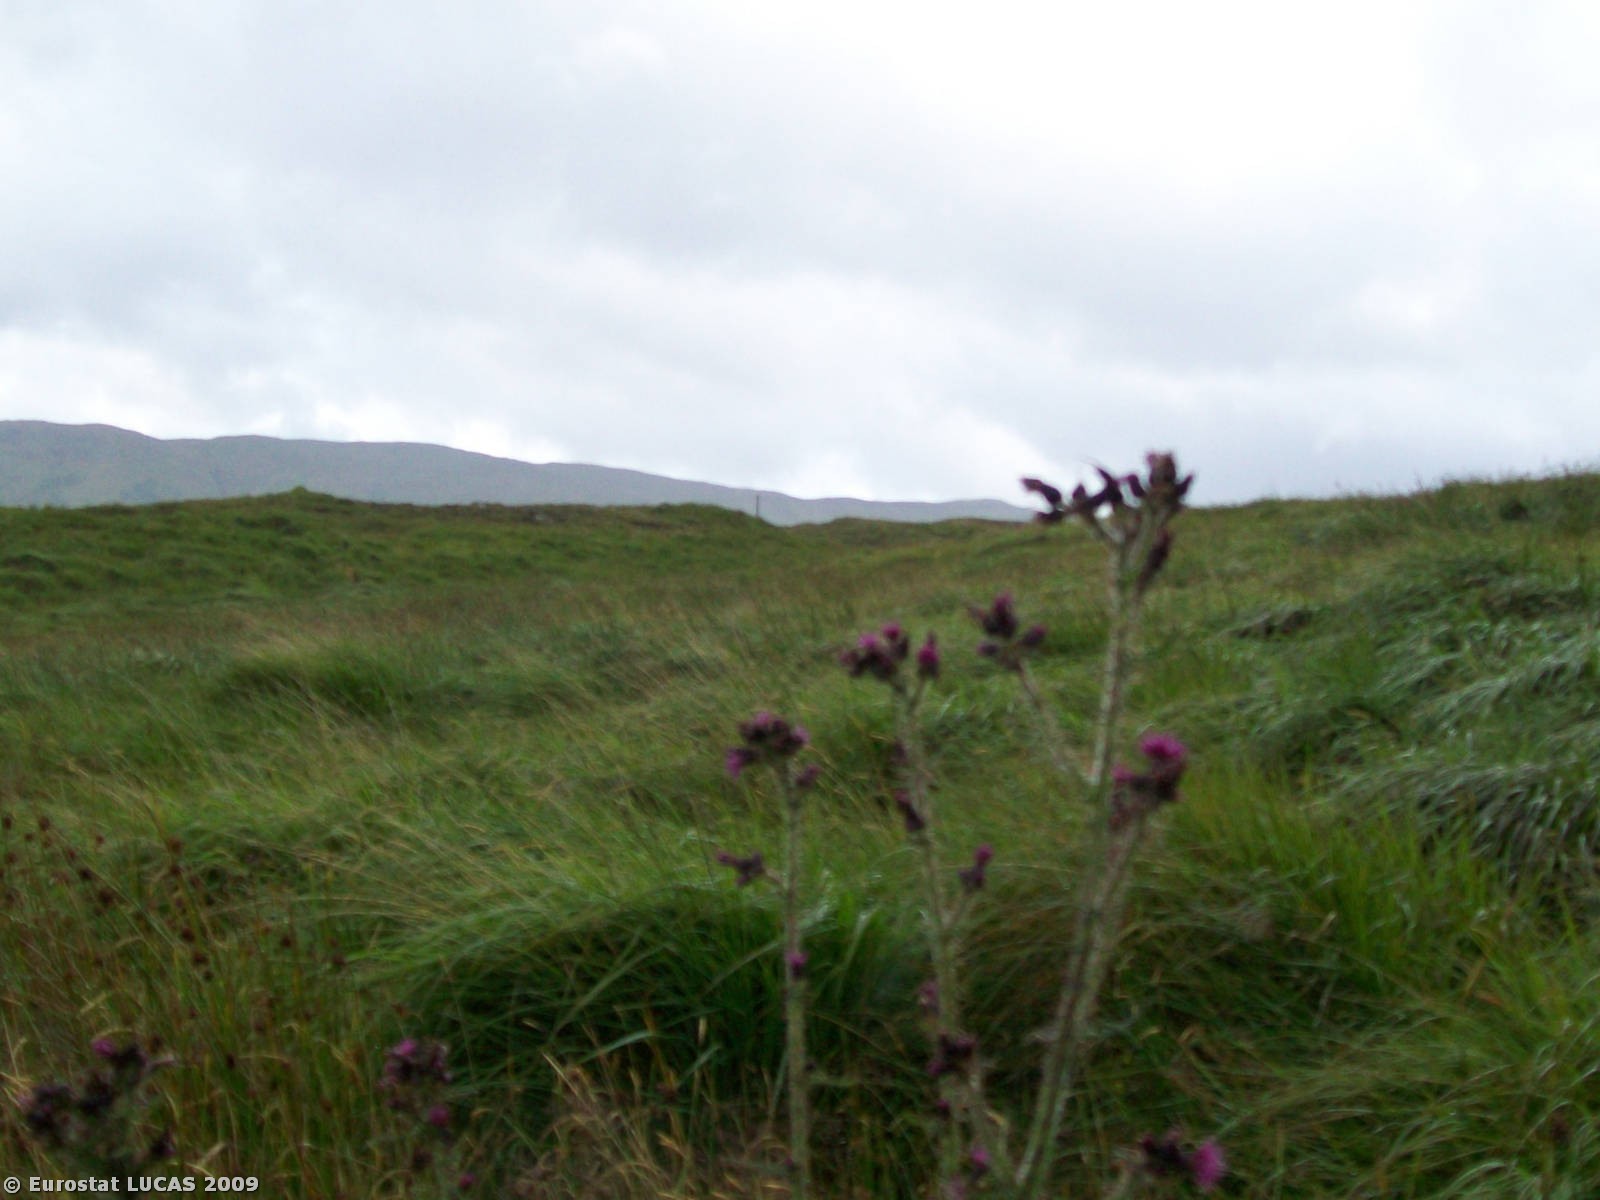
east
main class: Grassland
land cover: Grassland without tree/shrub cover
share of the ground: > 75 %
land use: Agriculture (excluding fallow land and kitchen gardens)
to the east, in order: Grassland without tree/shrub cover
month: July
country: IE
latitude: 53.6094
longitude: -9.5034
